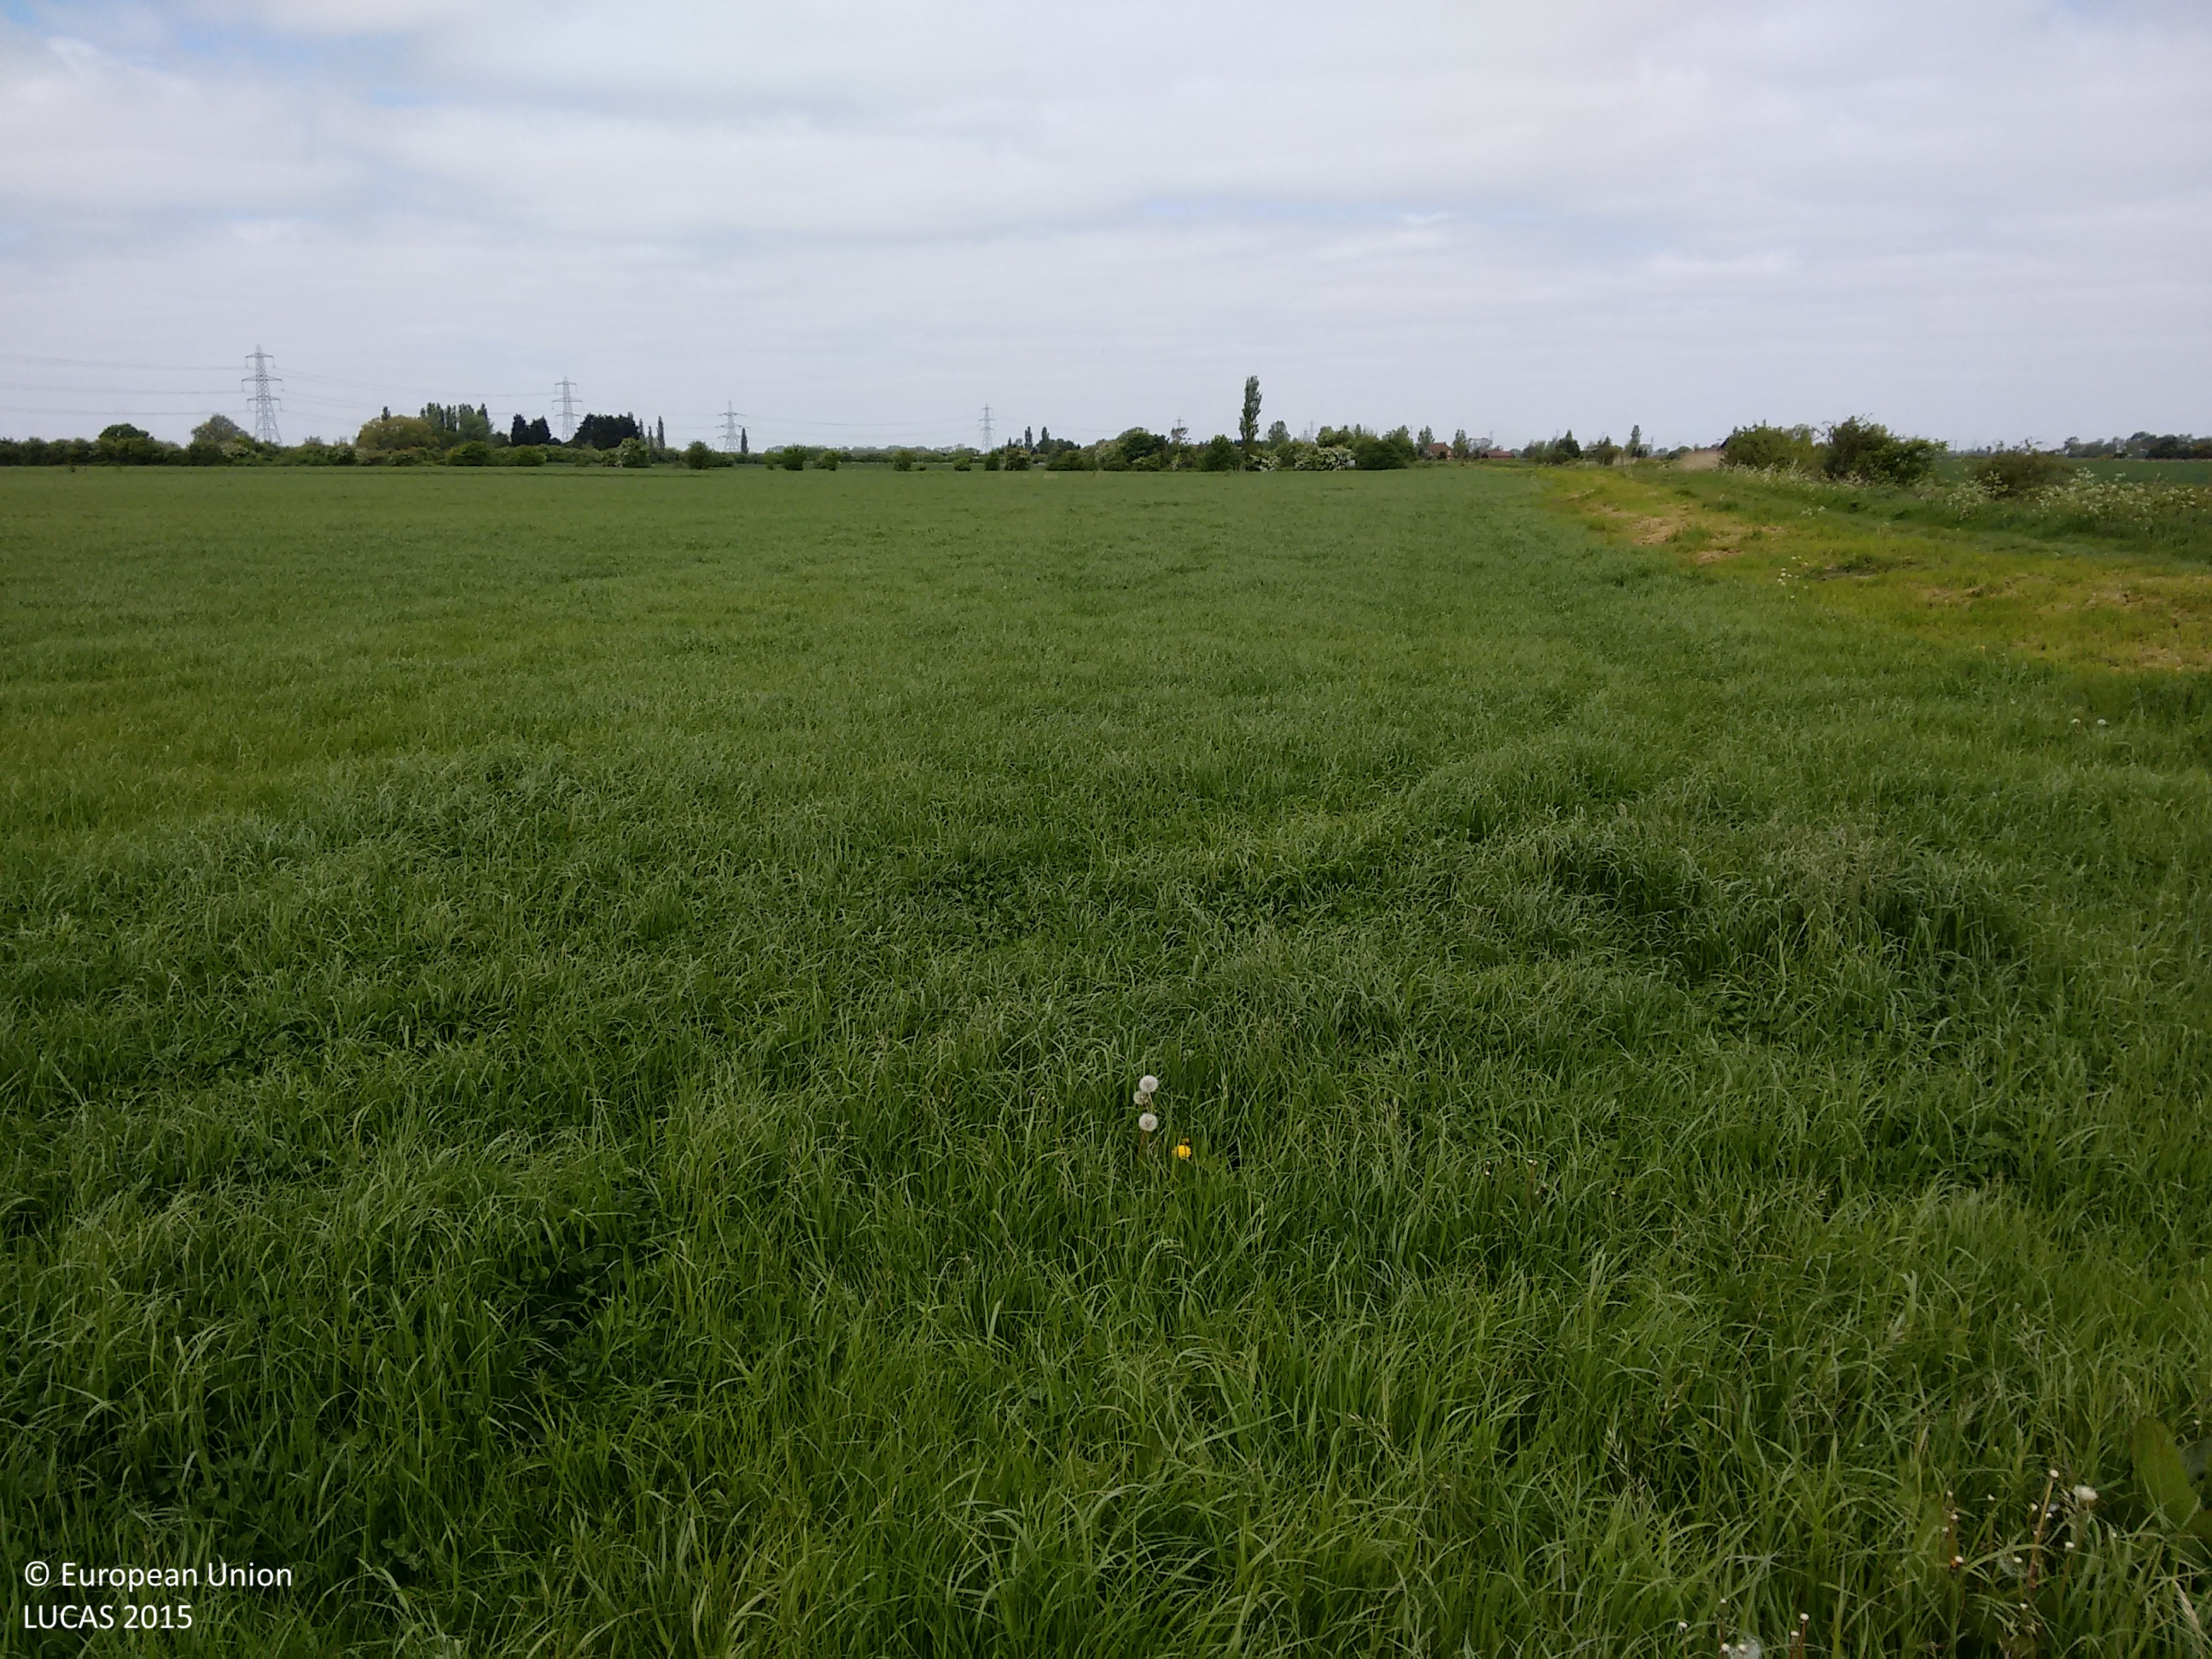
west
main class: Grassland
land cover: Grassland without tree/shrub cover
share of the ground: > 75 %
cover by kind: herbaceous plants 100 %
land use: Agriculture (excluding fallow land and kitchen gardens)
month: May
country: GB
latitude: 52.7739
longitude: 0.0515
